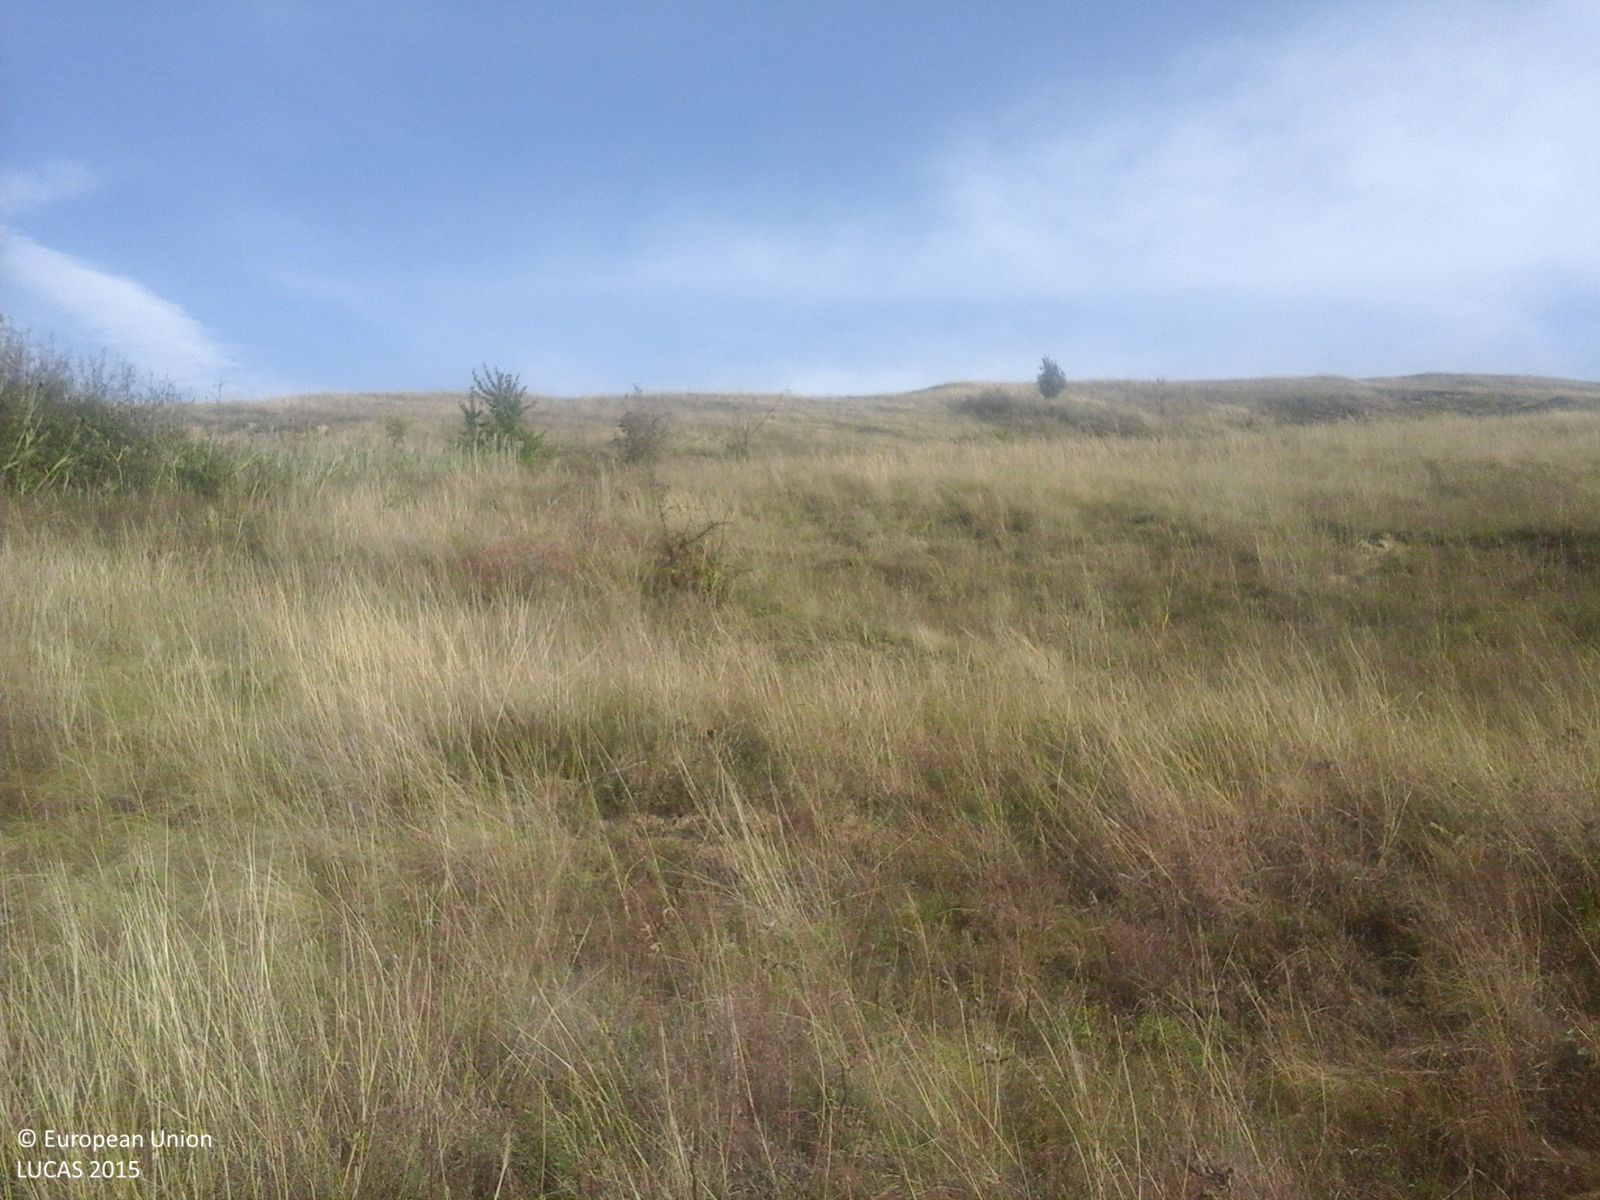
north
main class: Grassland
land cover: Grassland without tree/shrub cover
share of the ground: > 75 %
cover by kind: herbaceous plants 100 %
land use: Agriculture (excluding fallow land and kitchen gardens)
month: September
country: RO
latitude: 46.8002
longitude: 23.8199
